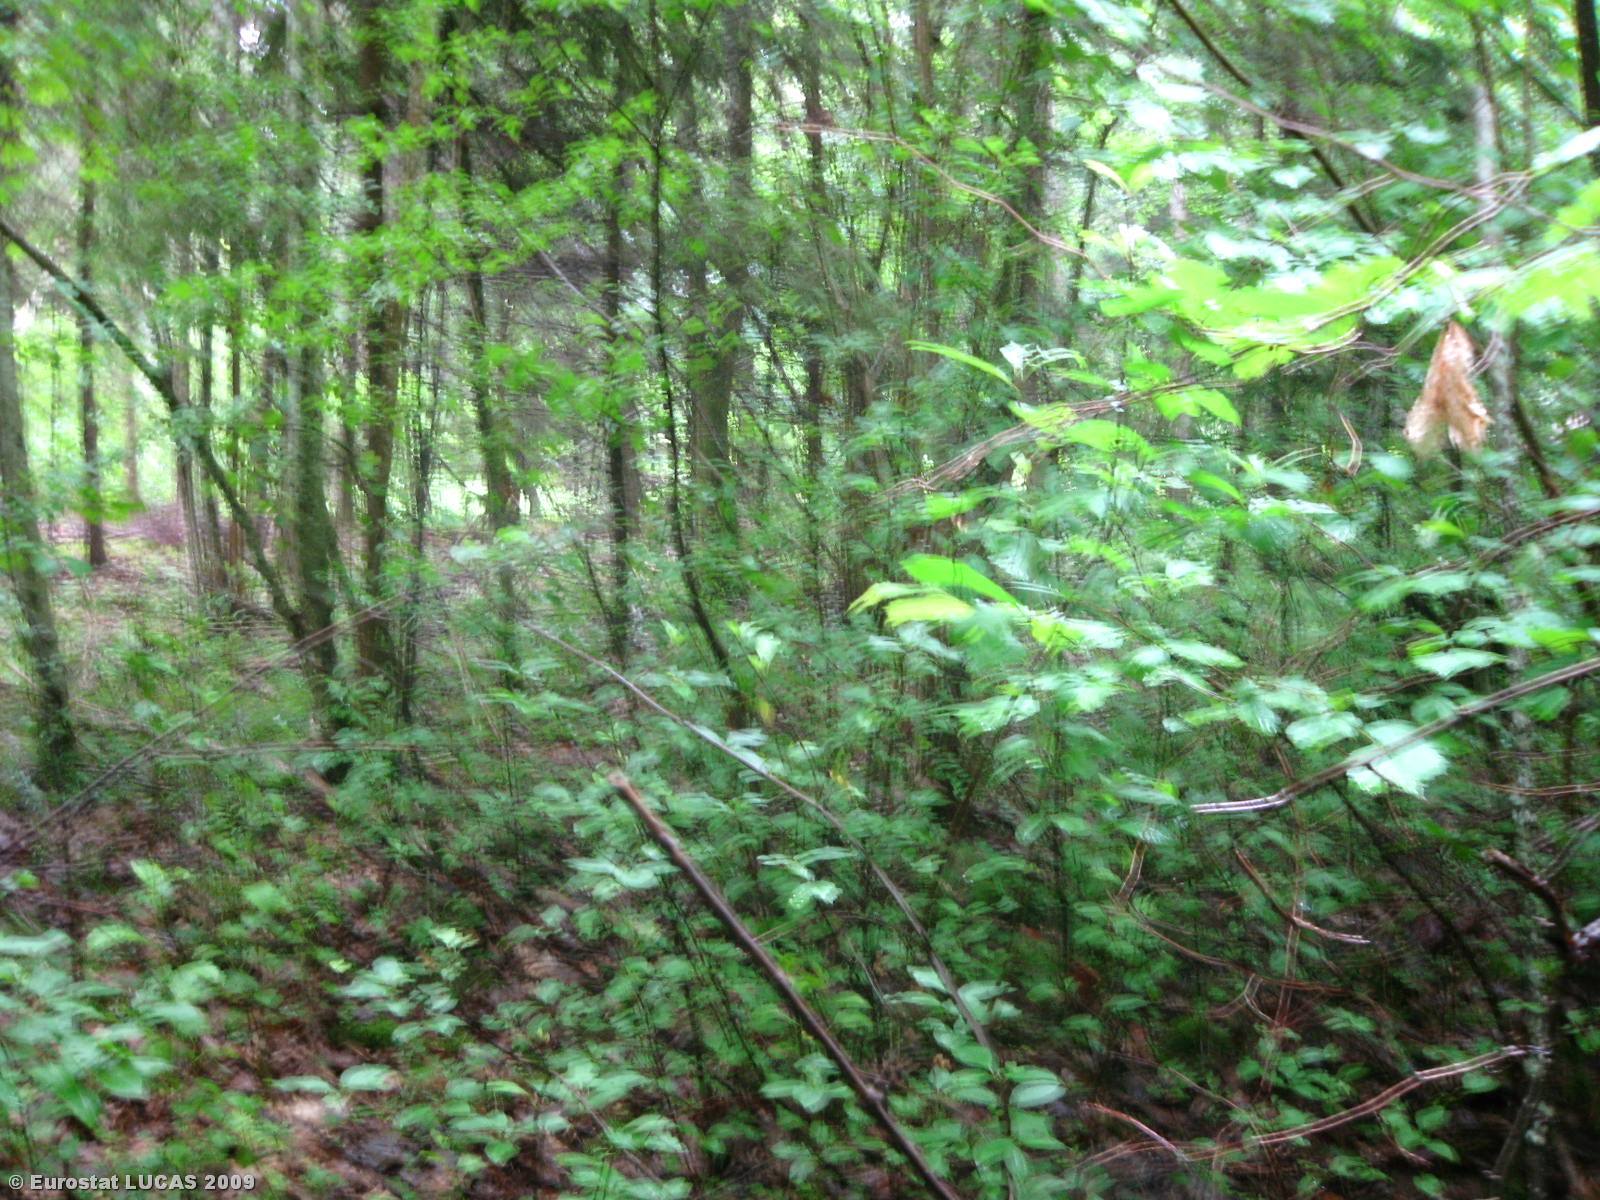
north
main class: Woodland
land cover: Mixed woodland
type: hemiboreal forest and nemoral coniferous forest and mixed broadleaved-coniferous forest
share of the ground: > 75 %
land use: Forestry
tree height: > 5 m
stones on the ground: < 10 %
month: July
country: LT
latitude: 55.1525
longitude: 24.8446
